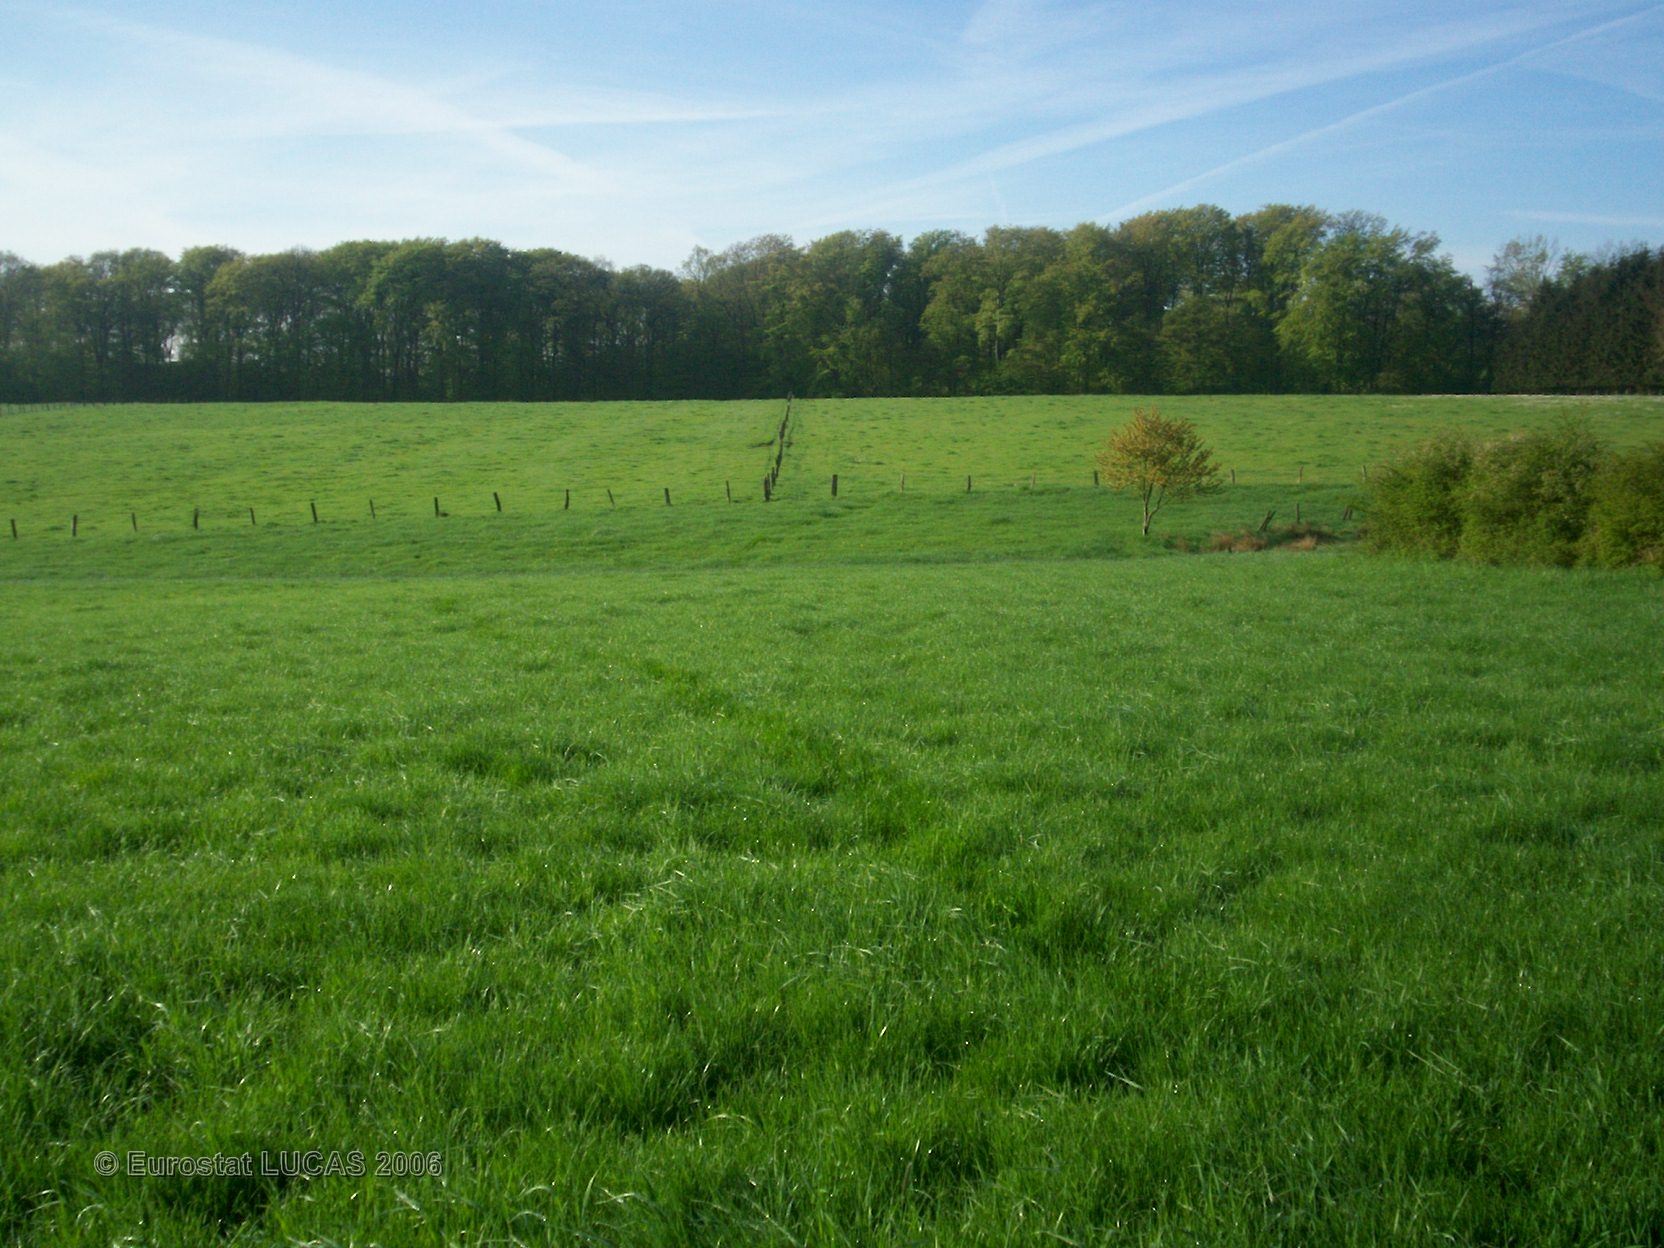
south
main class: Grassland
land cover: Grassland without tree/shrub cover
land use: Agriculture (excluding fallow land and kitchen gardens)
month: May
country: FR
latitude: 49.0987
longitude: 6.9187
